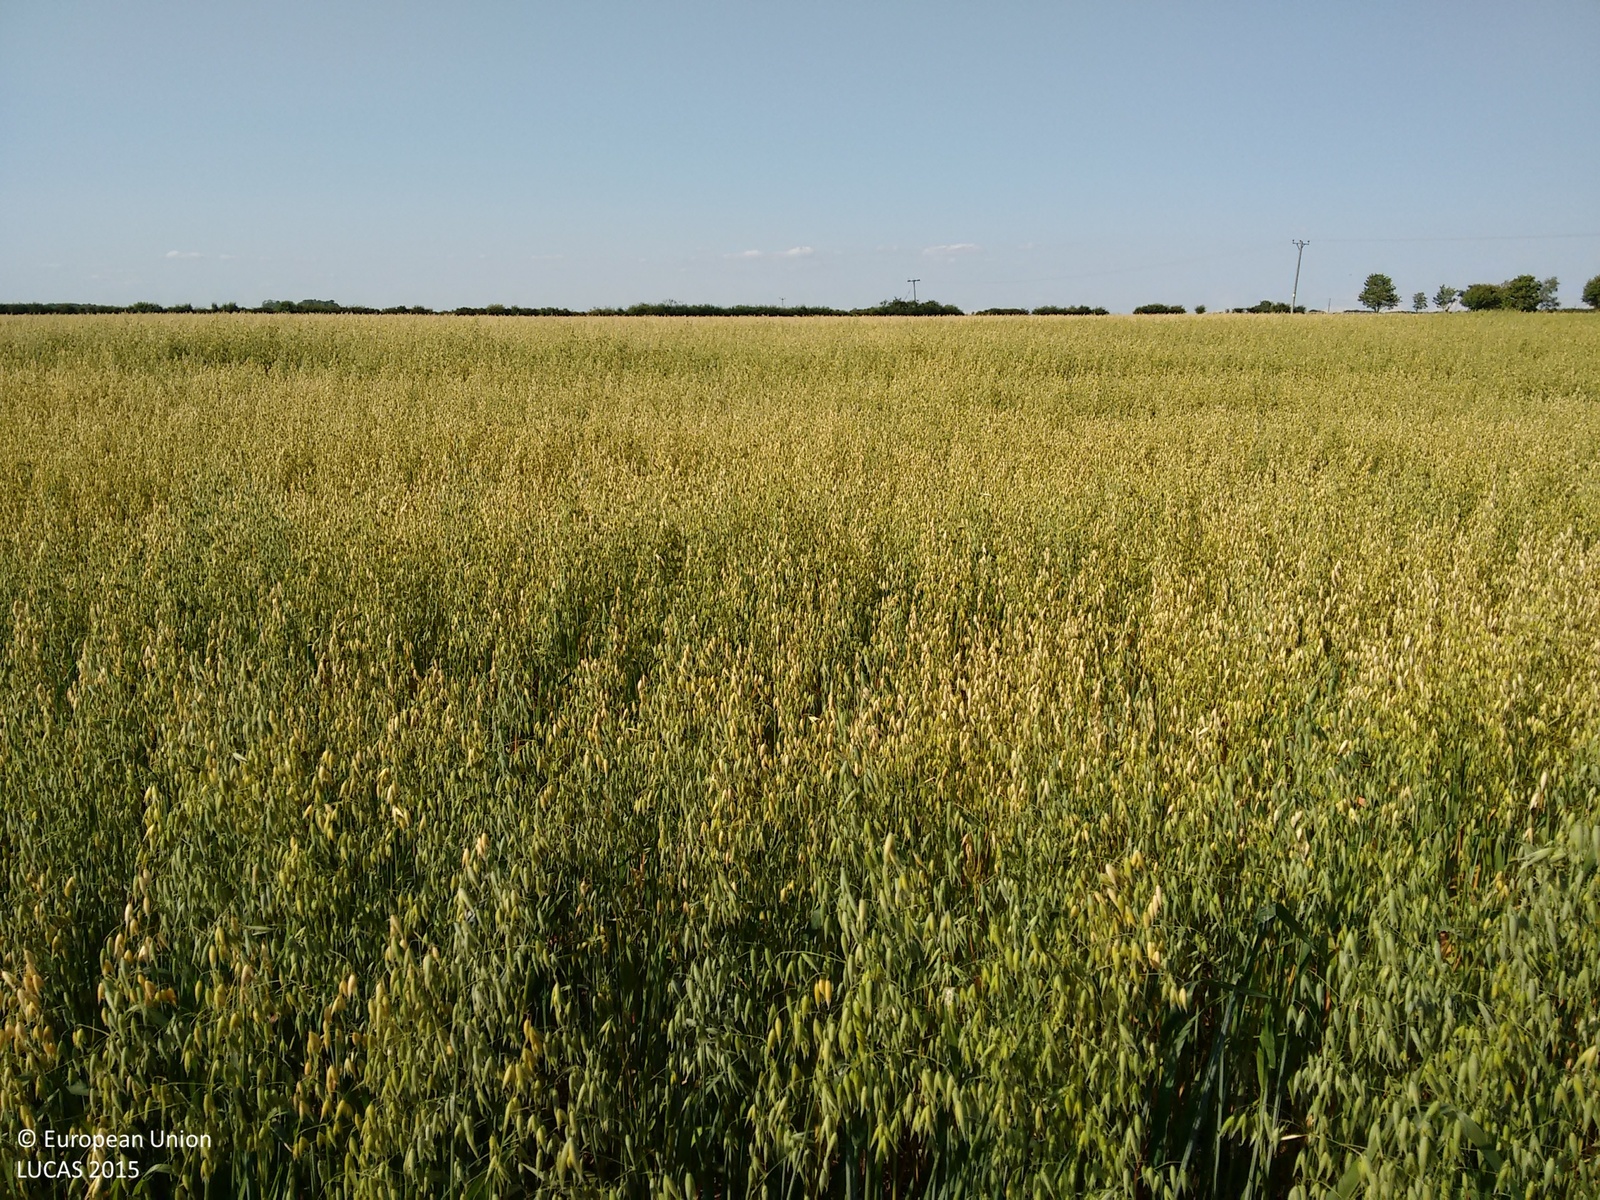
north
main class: Cropland
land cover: Oats
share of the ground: > 75 %
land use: Agriculture (excluding fallow land and kitchen gardens)
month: July
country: GB
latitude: 52.7056
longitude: -0.5315
